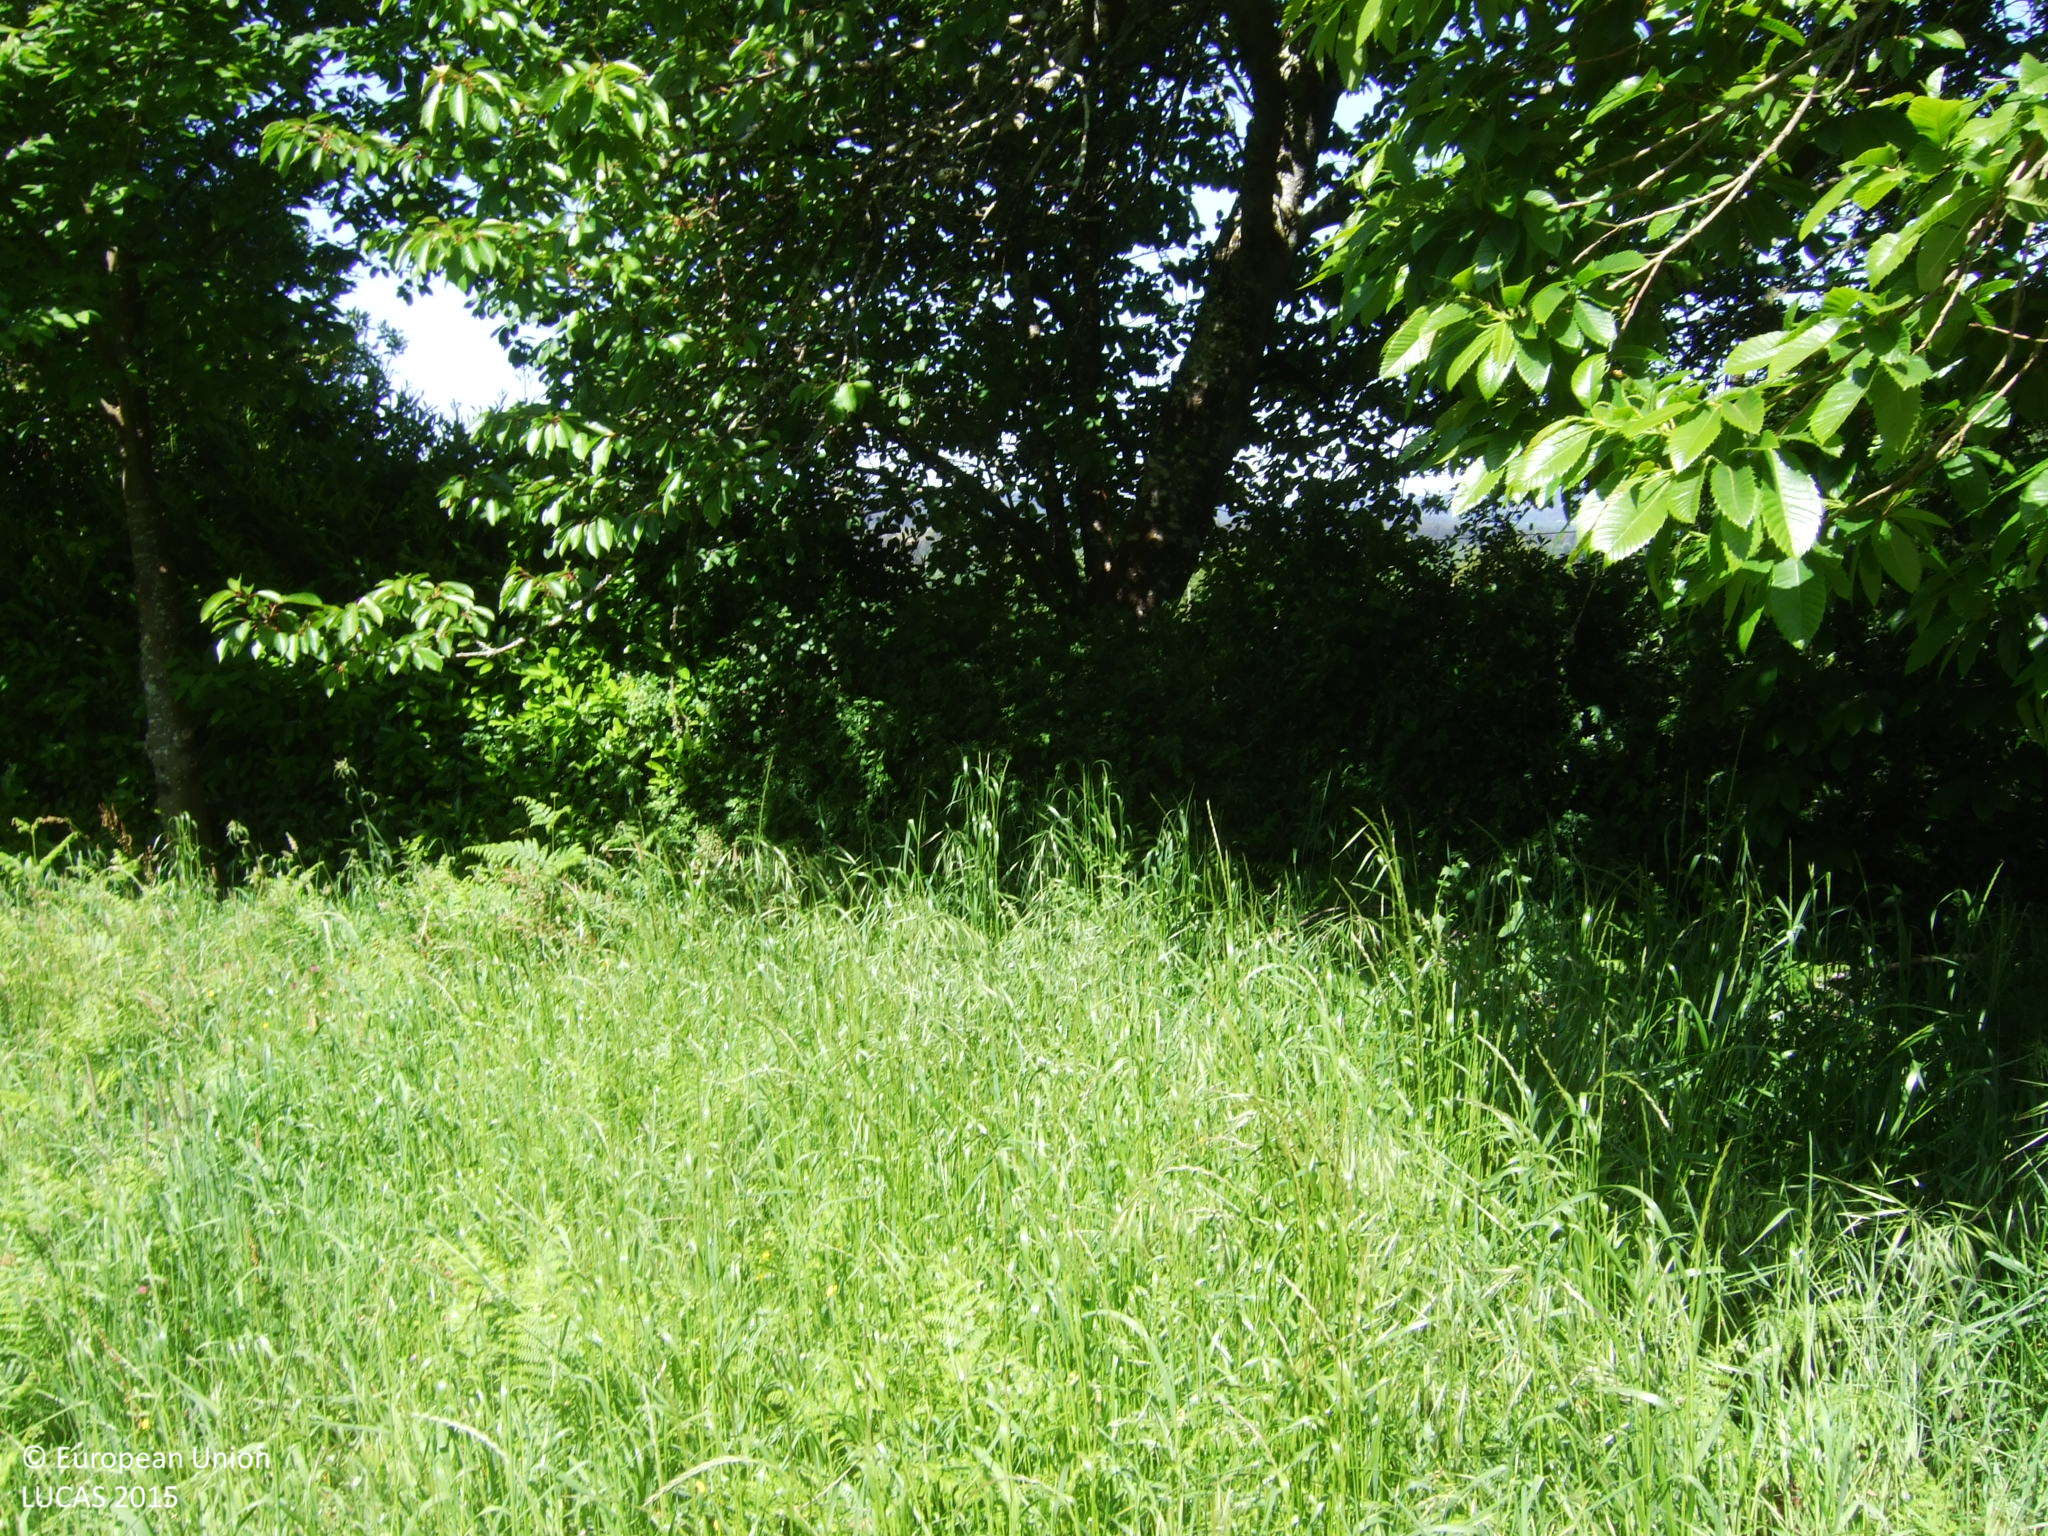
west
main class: Cropland
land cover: Potatoes
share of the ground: < 10 %
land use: Agriculture (excluding fallow land and kitchen gardens)
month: May
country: ES
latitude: 43.1496
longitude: -7.6788
